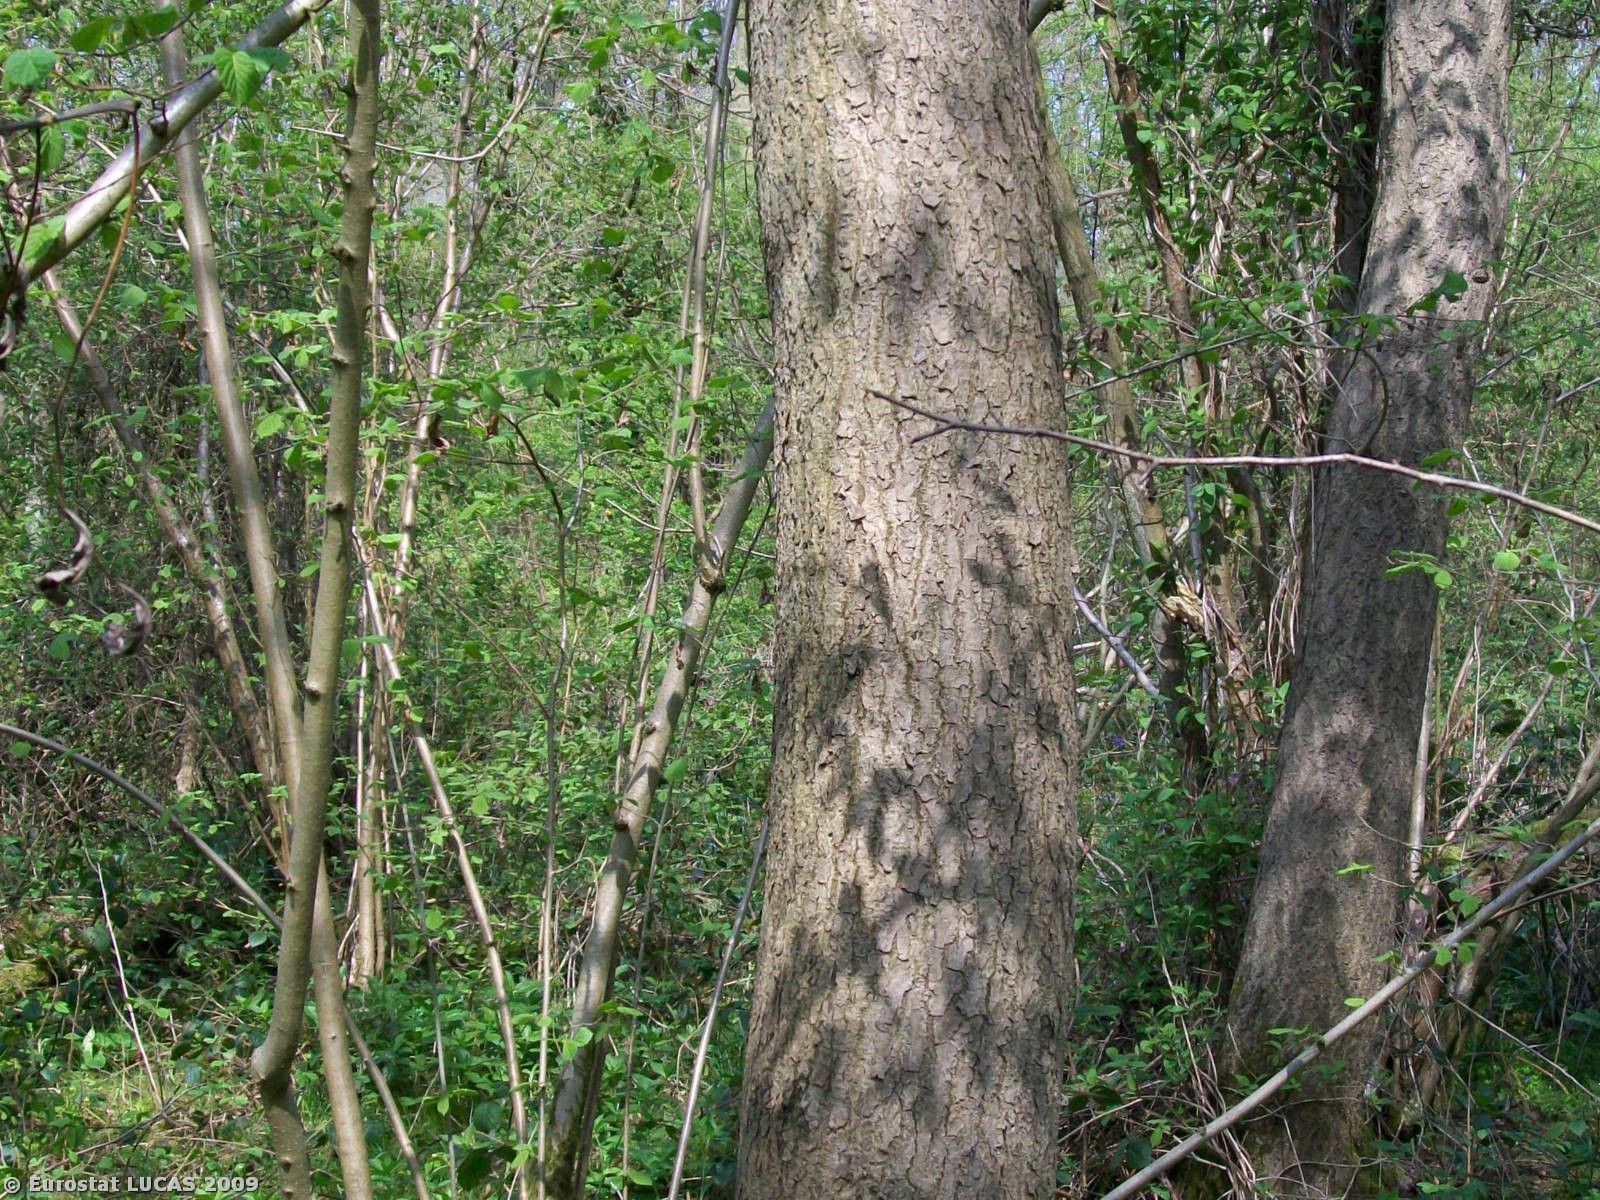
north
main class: Woodland
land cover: Mixed woodland
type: mesophytic deciduous forest
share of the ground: > 75 %
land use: Agriculture (excluding fallow land and kitchen gardens)
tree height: > 5 m
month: April
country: GB
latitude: 52.7924
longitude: -1.3637
